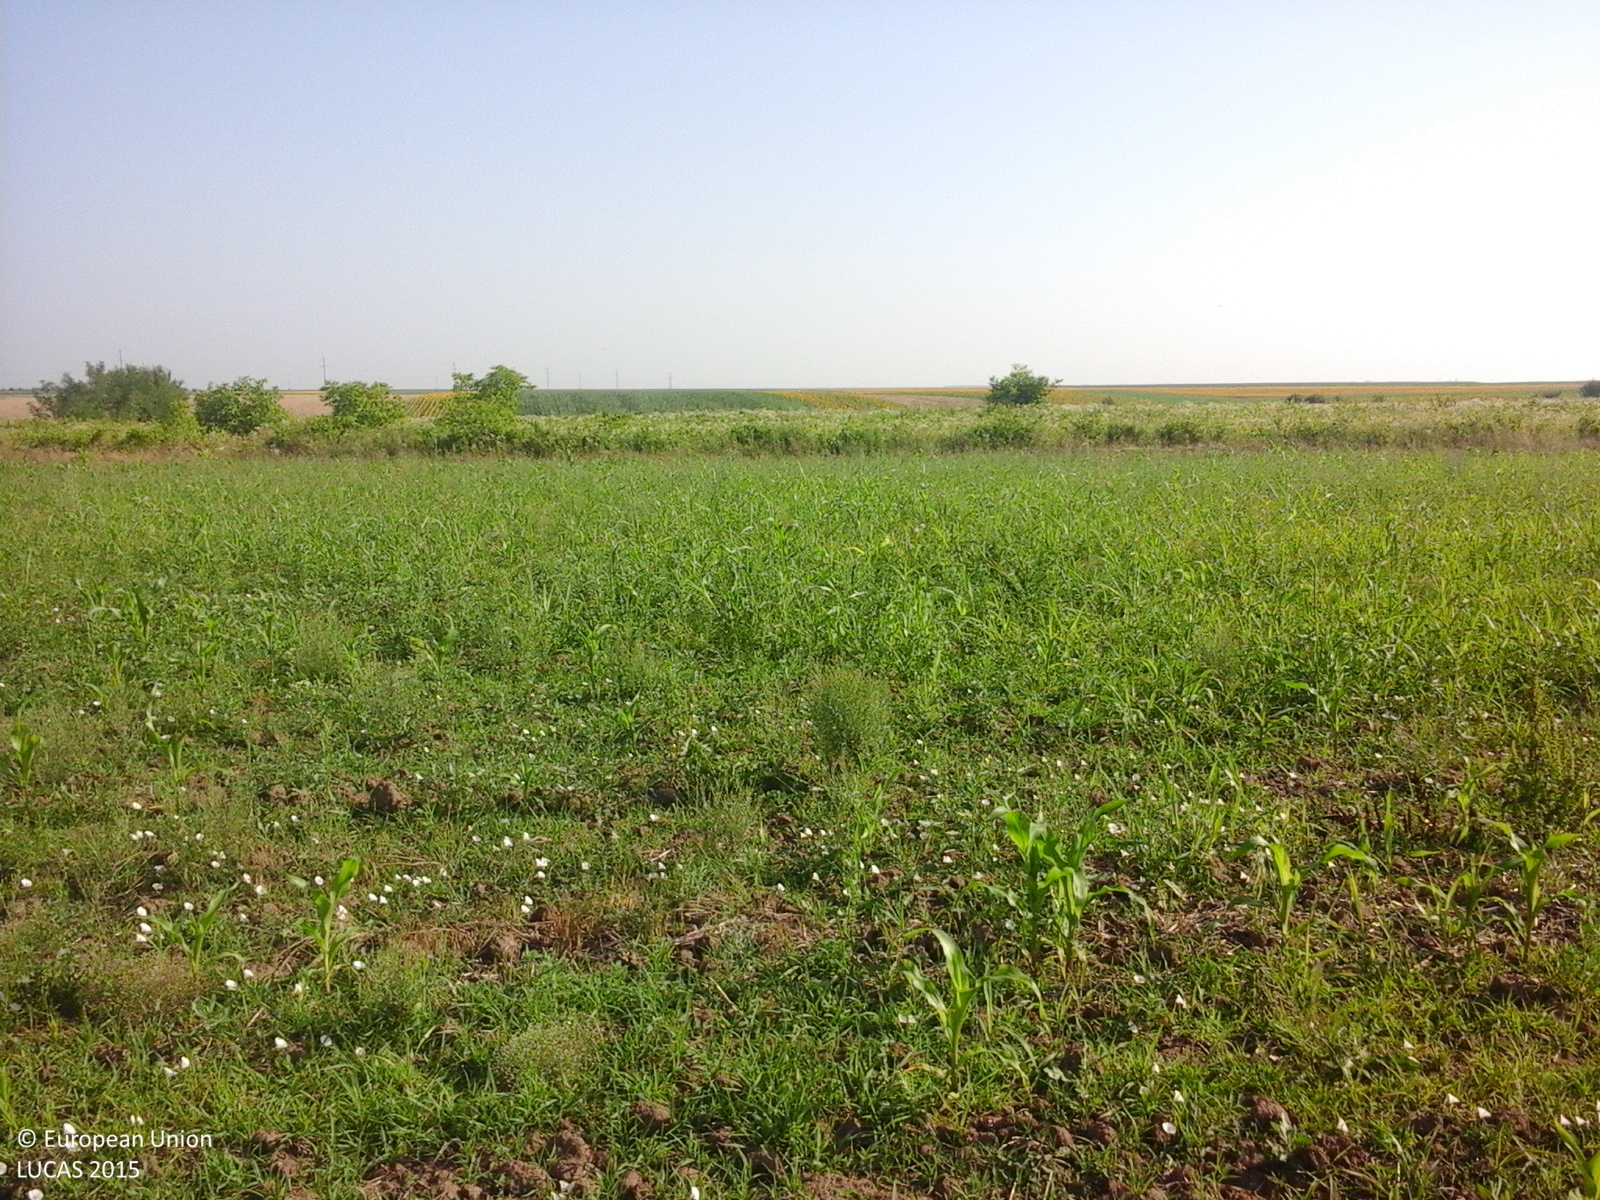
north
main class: Cropland
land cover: Maize
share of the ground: 25 - 50 %
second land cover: Spontaneously vegetated surfaces
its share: 50 - 75 %
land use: Agriculture (excluding fallow land and kitchen gardens)
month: July
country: RO
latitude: 44.1182
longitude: 25.3419
